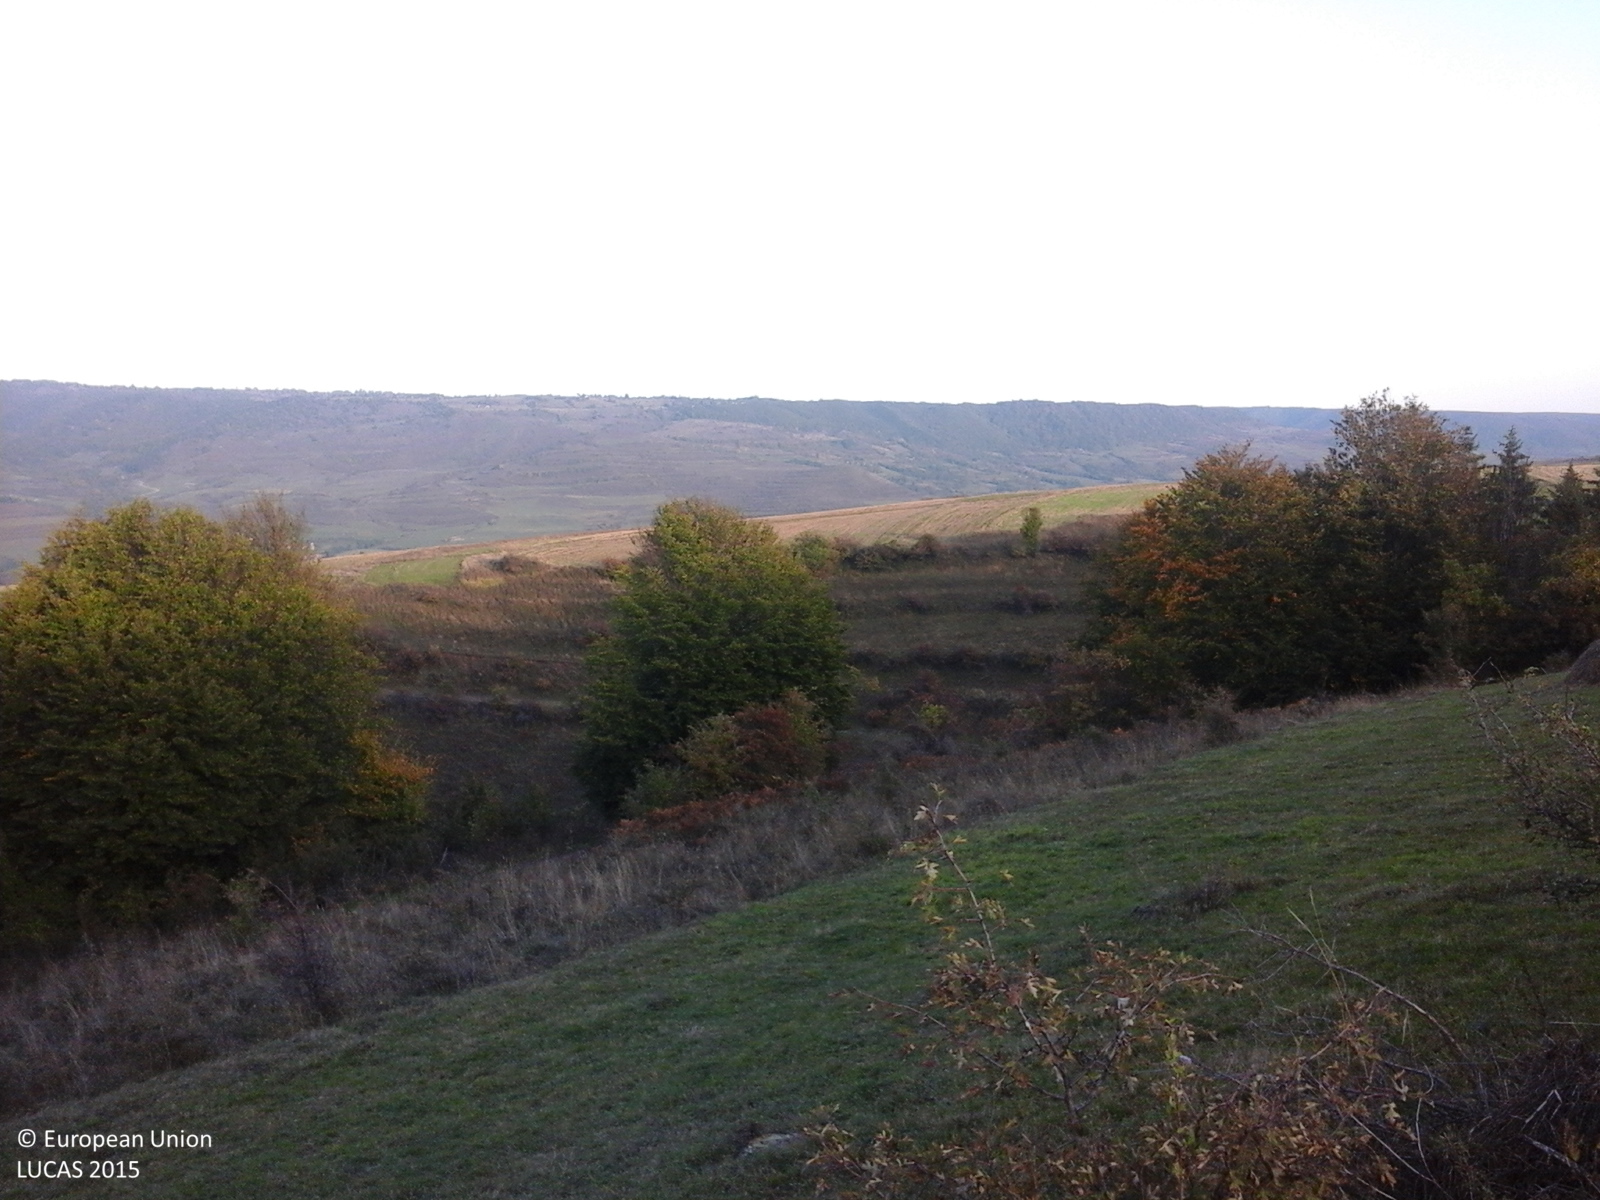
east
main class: Grassland
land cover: Grassland without tree/shrub cover
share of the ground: > 75 %
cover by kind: herbaceous plants 100 %
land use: Agriculture (excluding fallow land and kitchen gardens)
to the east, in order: Grass margins; Grassland without tree/shrub cover; Spontaneously vegetated surfaces; Grass margins; Tracks; Broadleaved woodland; Spontaneously vegetated surfaces; Tracks; Grass margins; Broadleaved woodland; Rivers and streams; Broadleaved woodland; Spontaneously vegetated surfaces; Shrubland without tree cover; Grass margins; Tracks; Grass margins; Abandoned hedges; Spontaneously vegetated surfaces; Abandoned hedges; Spontaneously vegetated surfaces
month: October
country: RO
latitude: 46.5127
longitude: 25.1277
